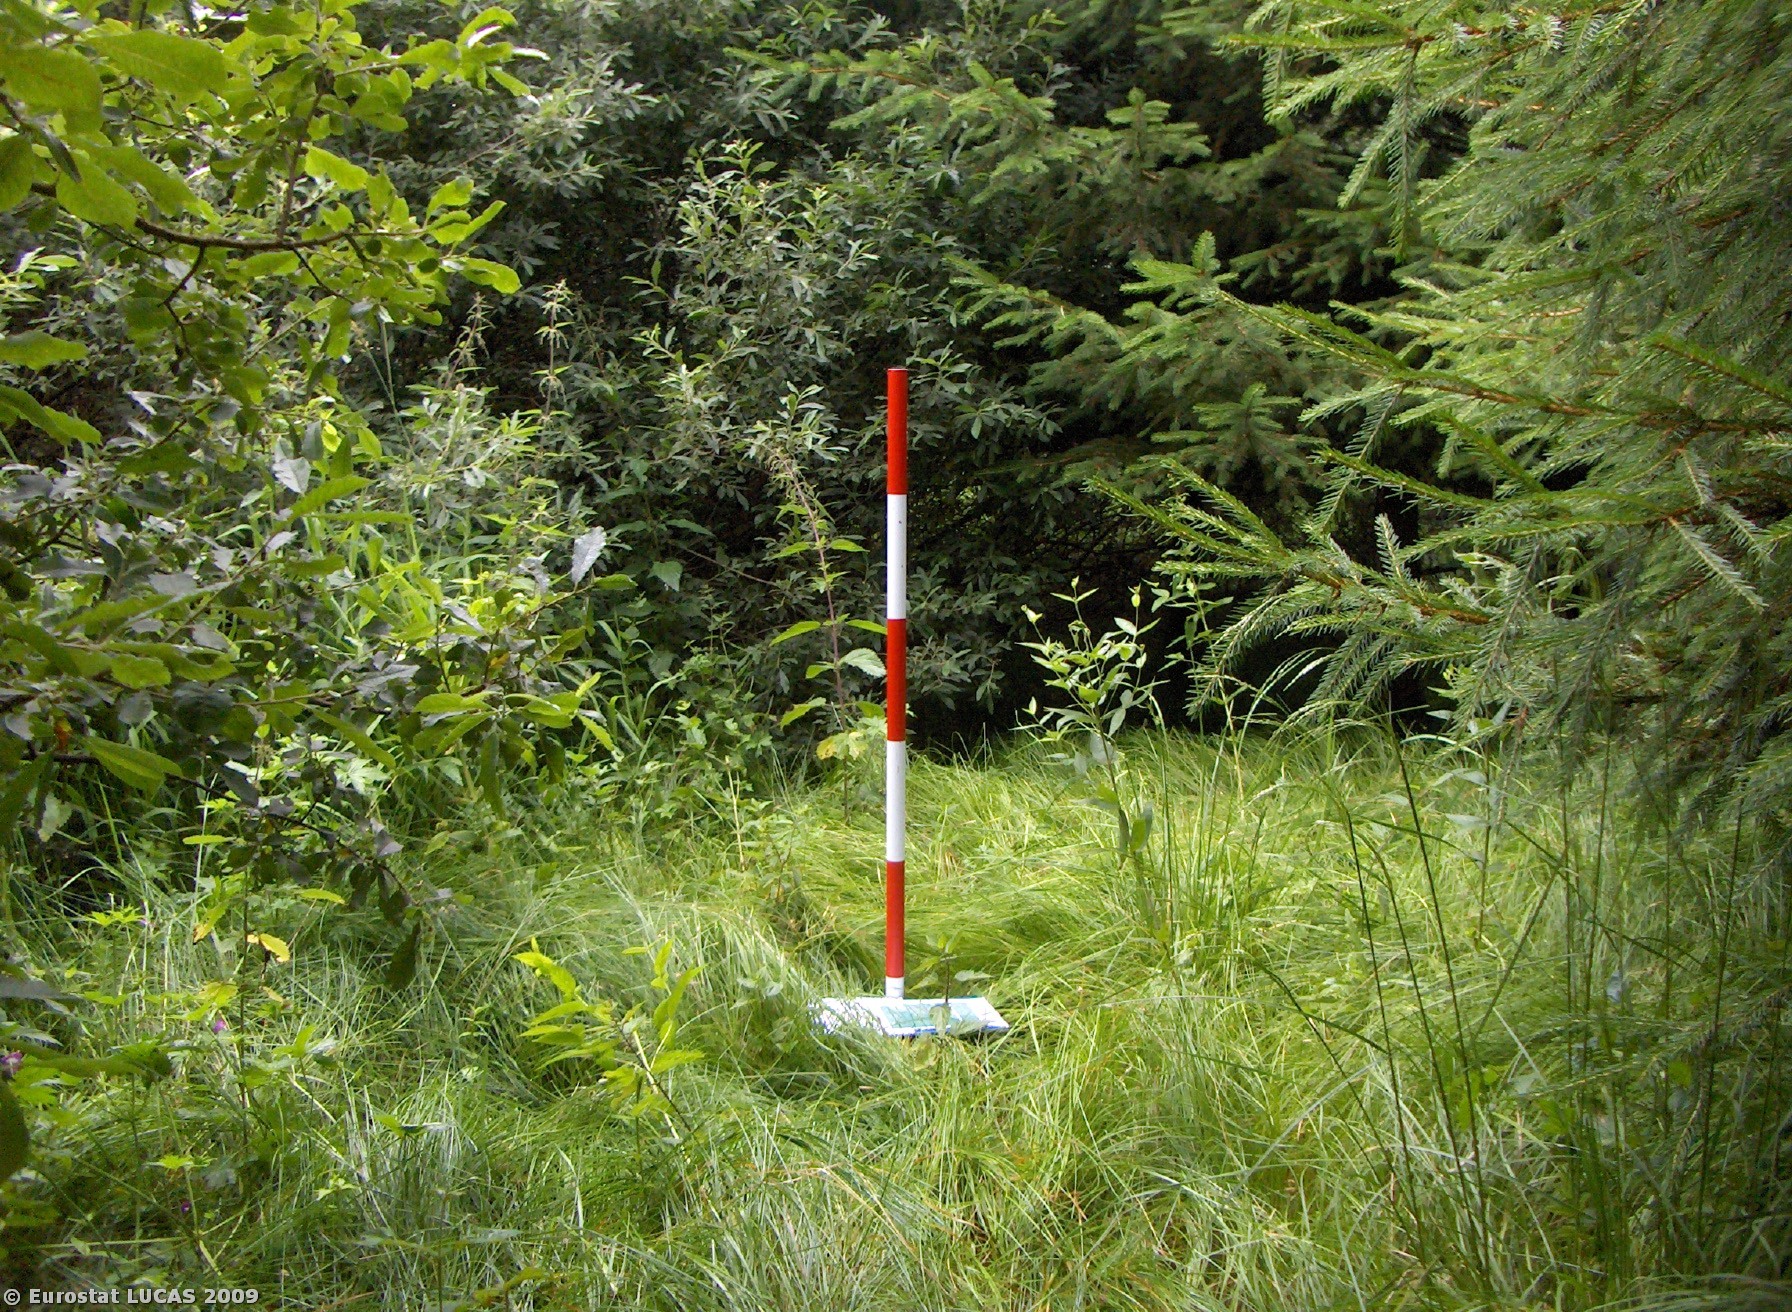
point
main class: Woodland
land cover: Mixed woodland
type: hemiboreal forest and nemoral coniferous forest and mixed broadleaved-coniferous forest
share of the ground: > 75 %
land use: Forestry
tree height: > 5 m
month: July
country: CZ
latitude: 49.4199
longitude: 13.1843
